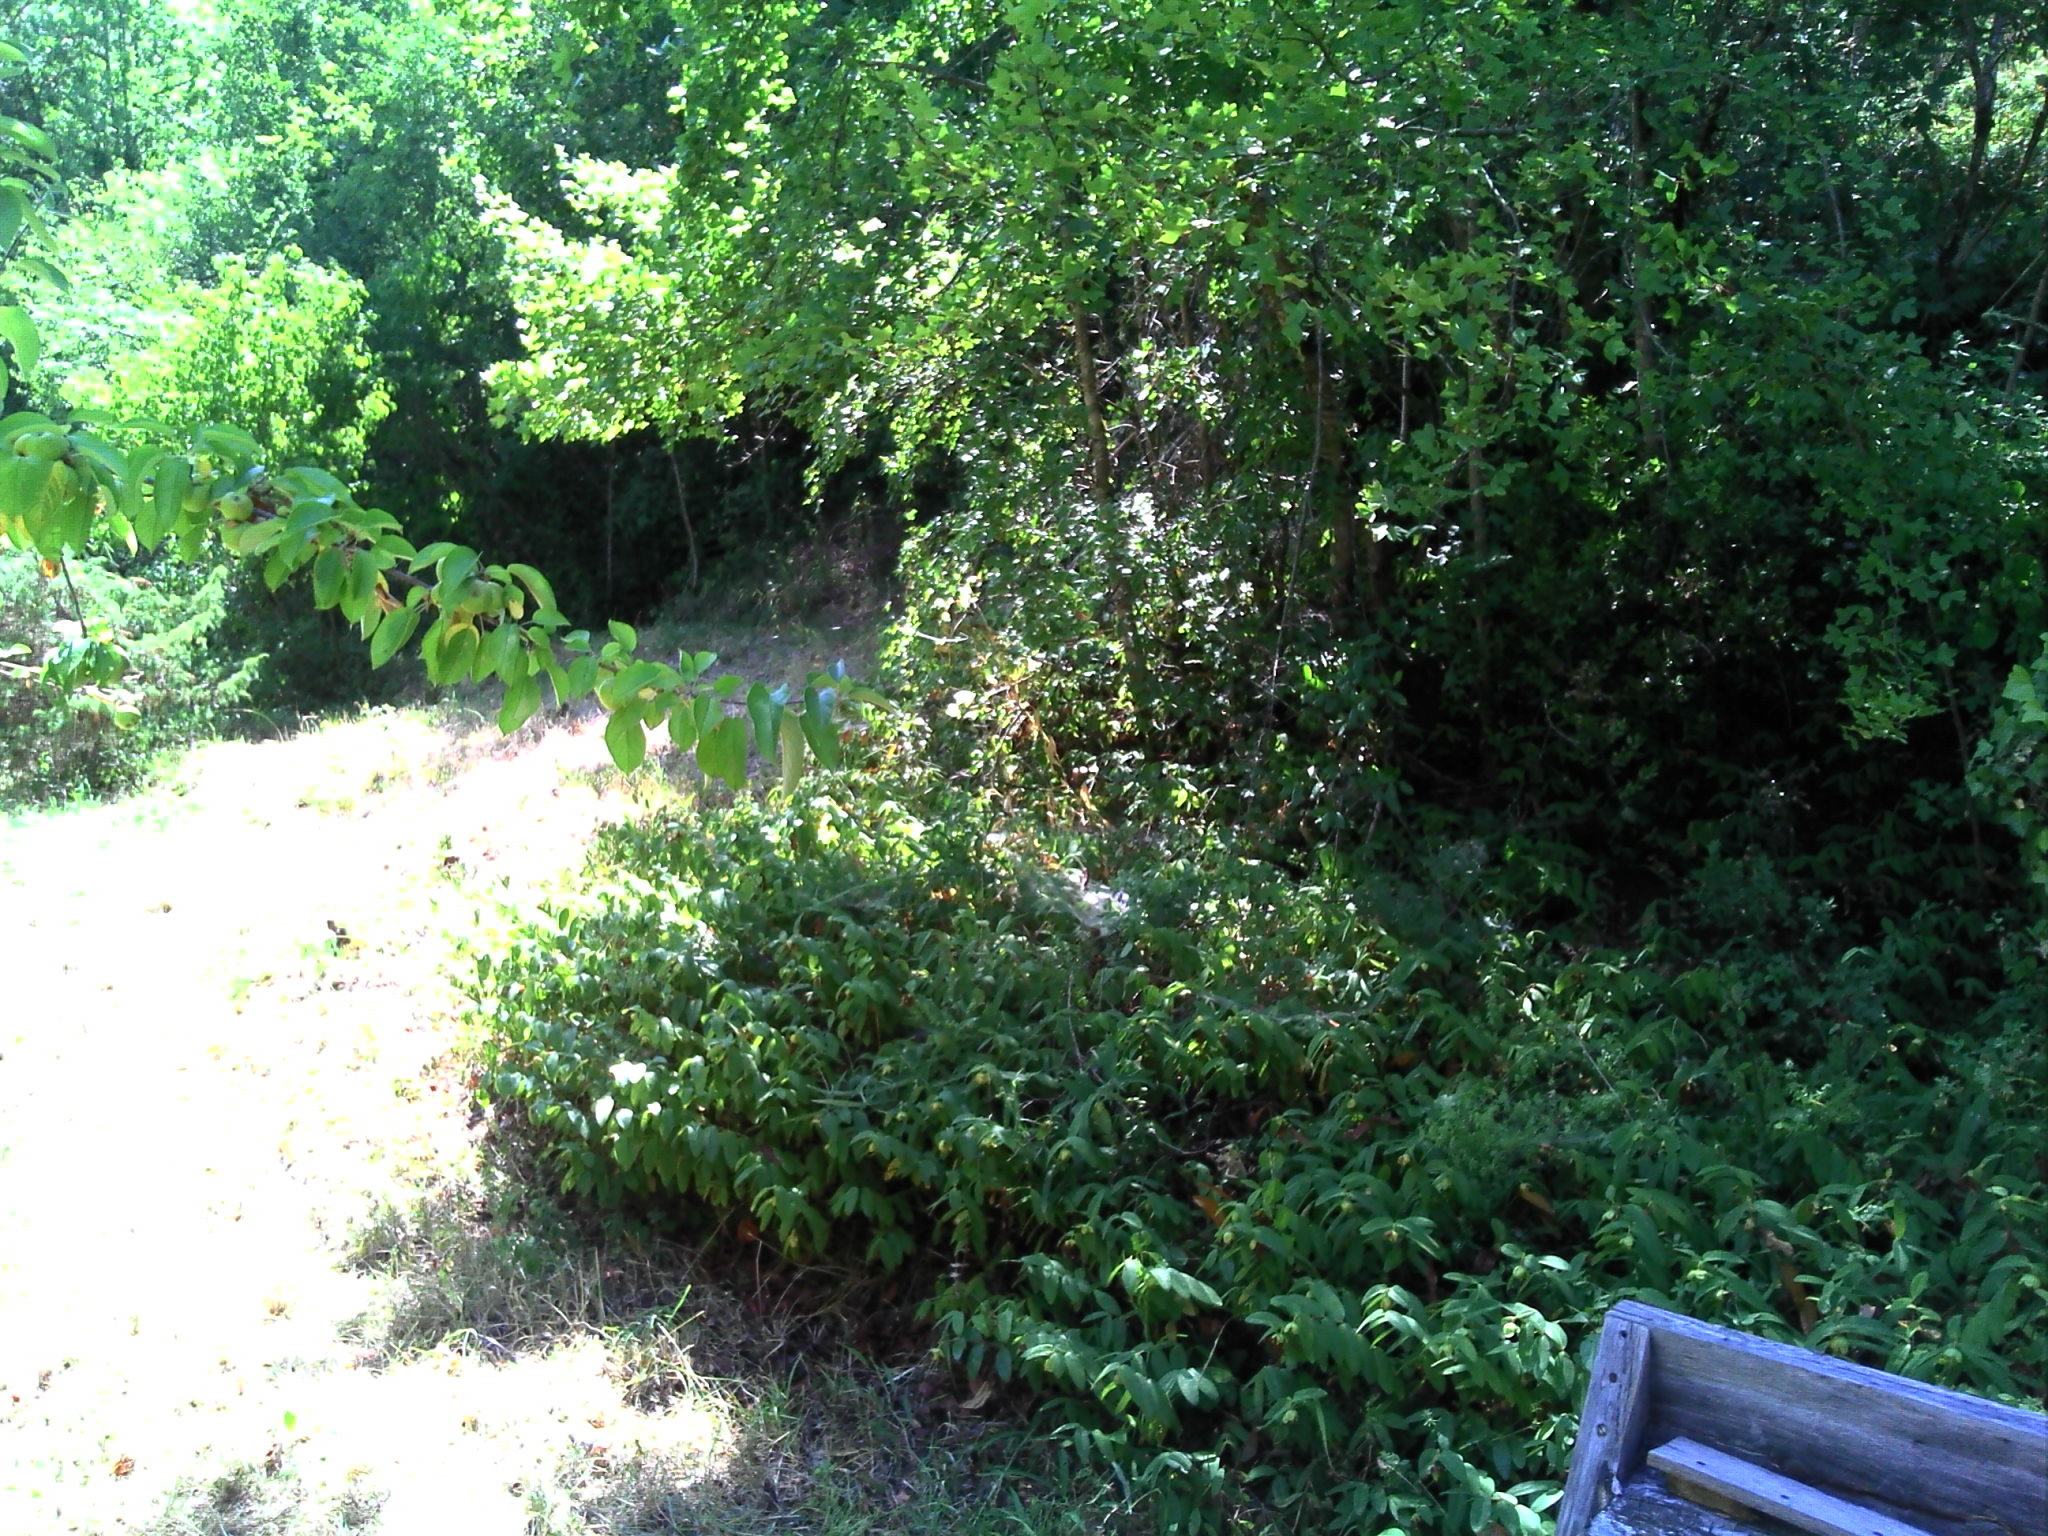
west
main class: Grassland
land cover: Grassland with sparse tree/shrub cover
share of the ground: > 75 %
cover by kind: herbaceous plants 95 %, broadleaved forest trees 5 %
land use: Residential
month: July
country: FR
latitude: 44.4687
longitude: 1.2355
